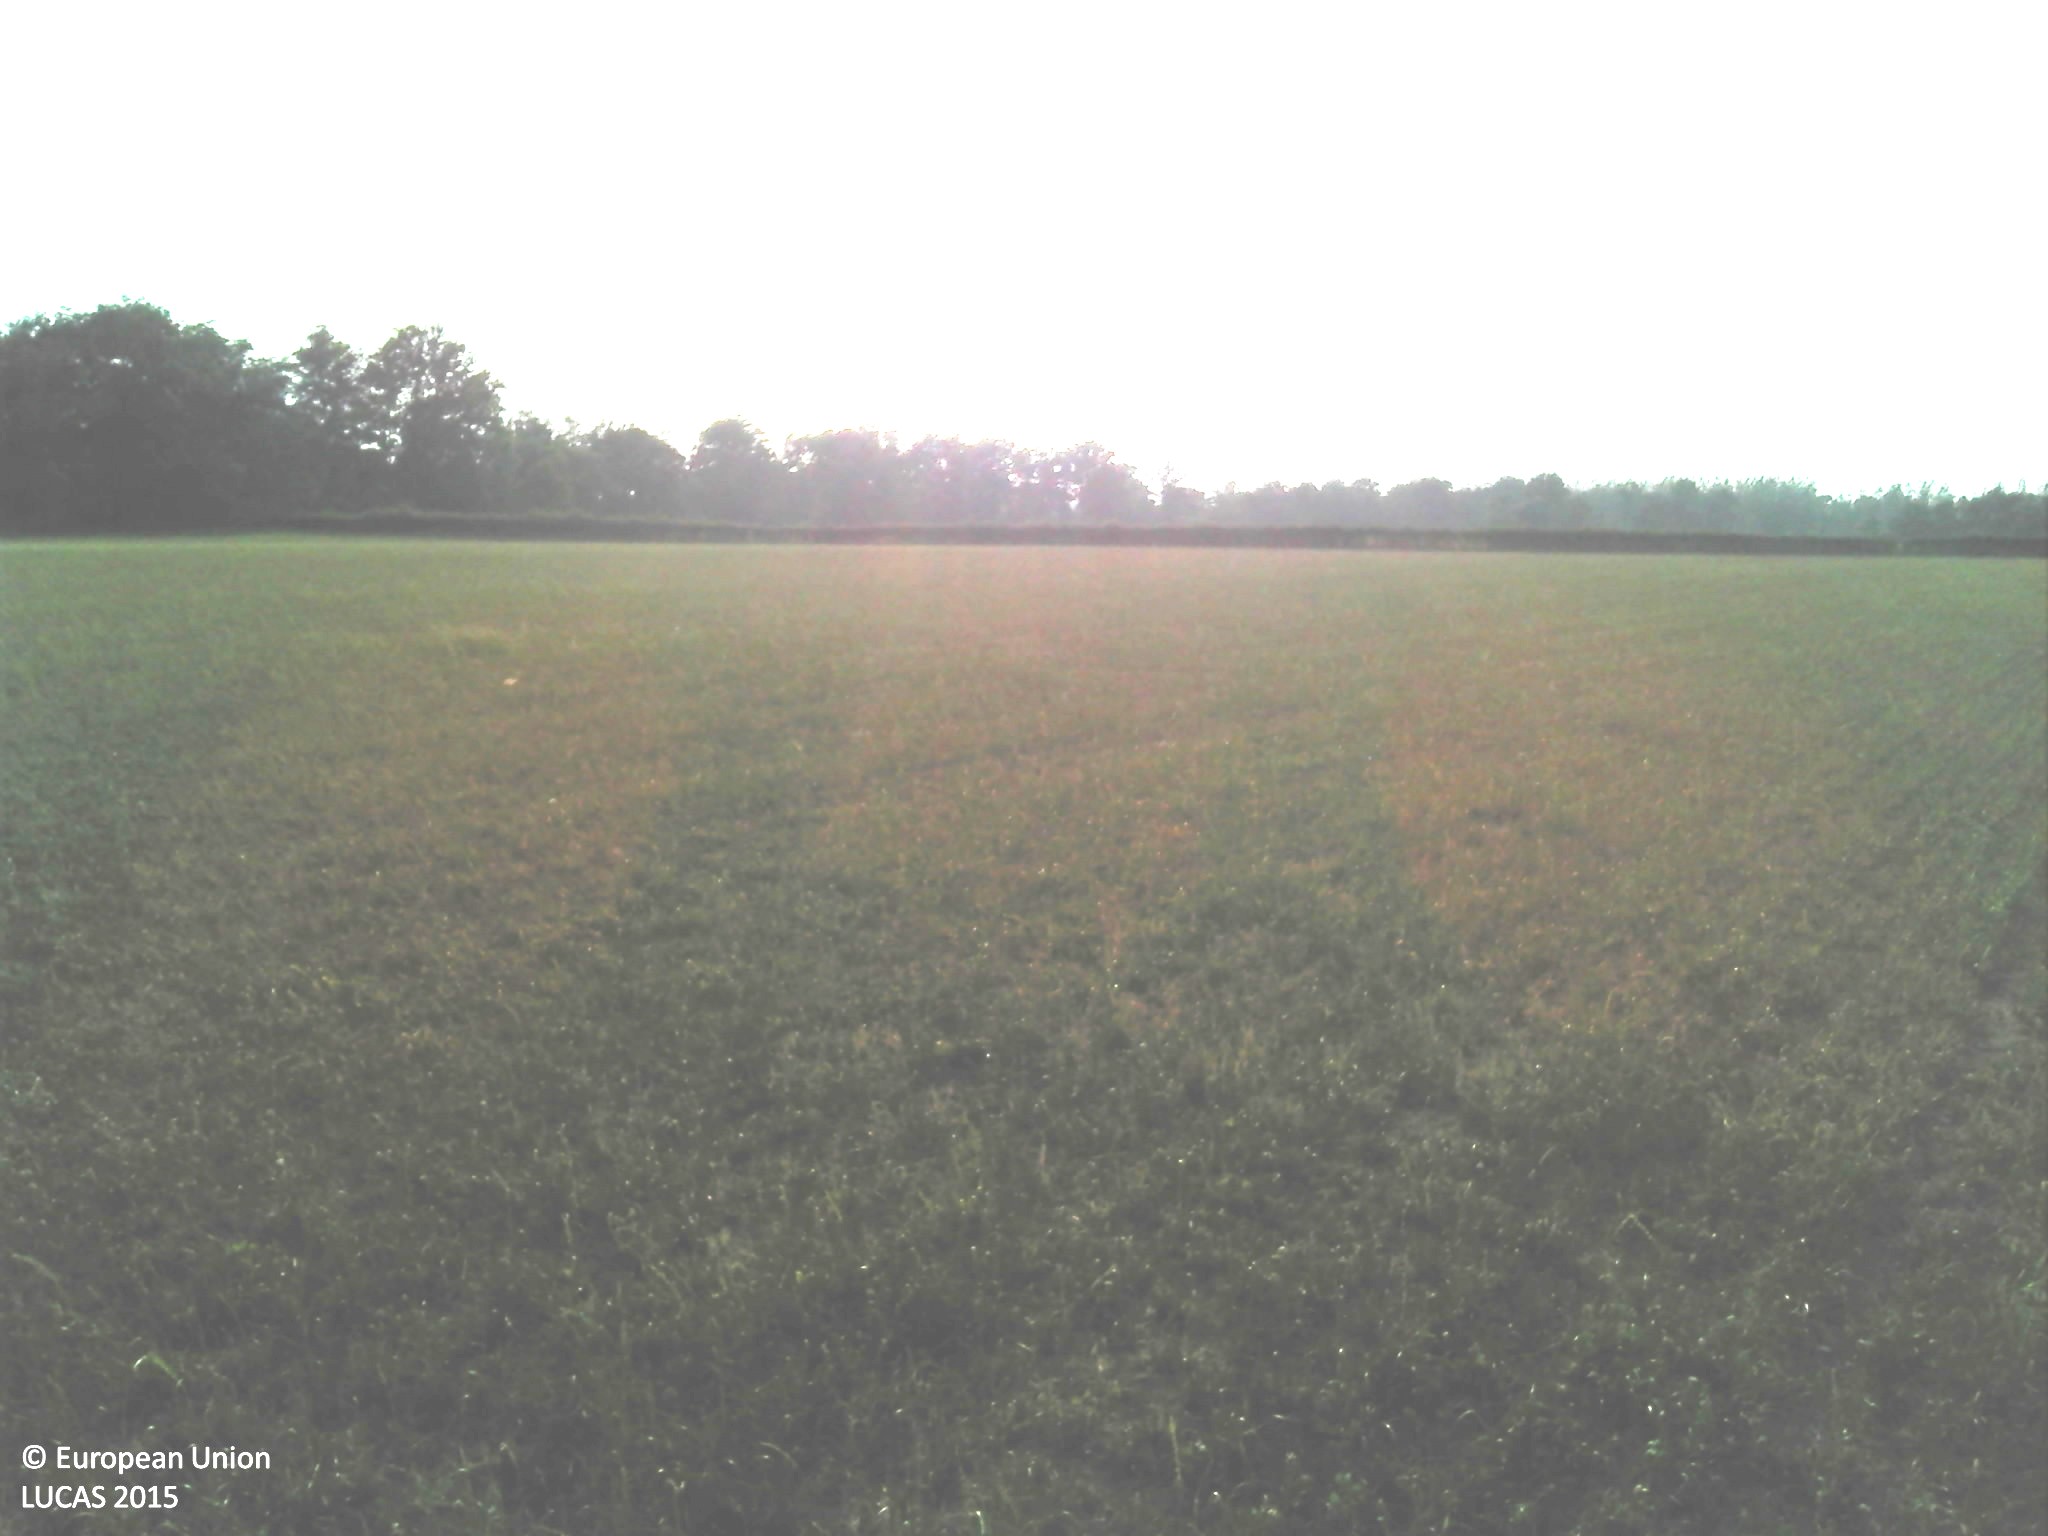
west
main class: Cropland
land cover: Temporary grasslands
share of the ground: > 75 %
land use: Agriculture (excluding fallow land and kitchen gardens)
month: July
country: FR
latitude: 46.7538
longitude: 3.5706
